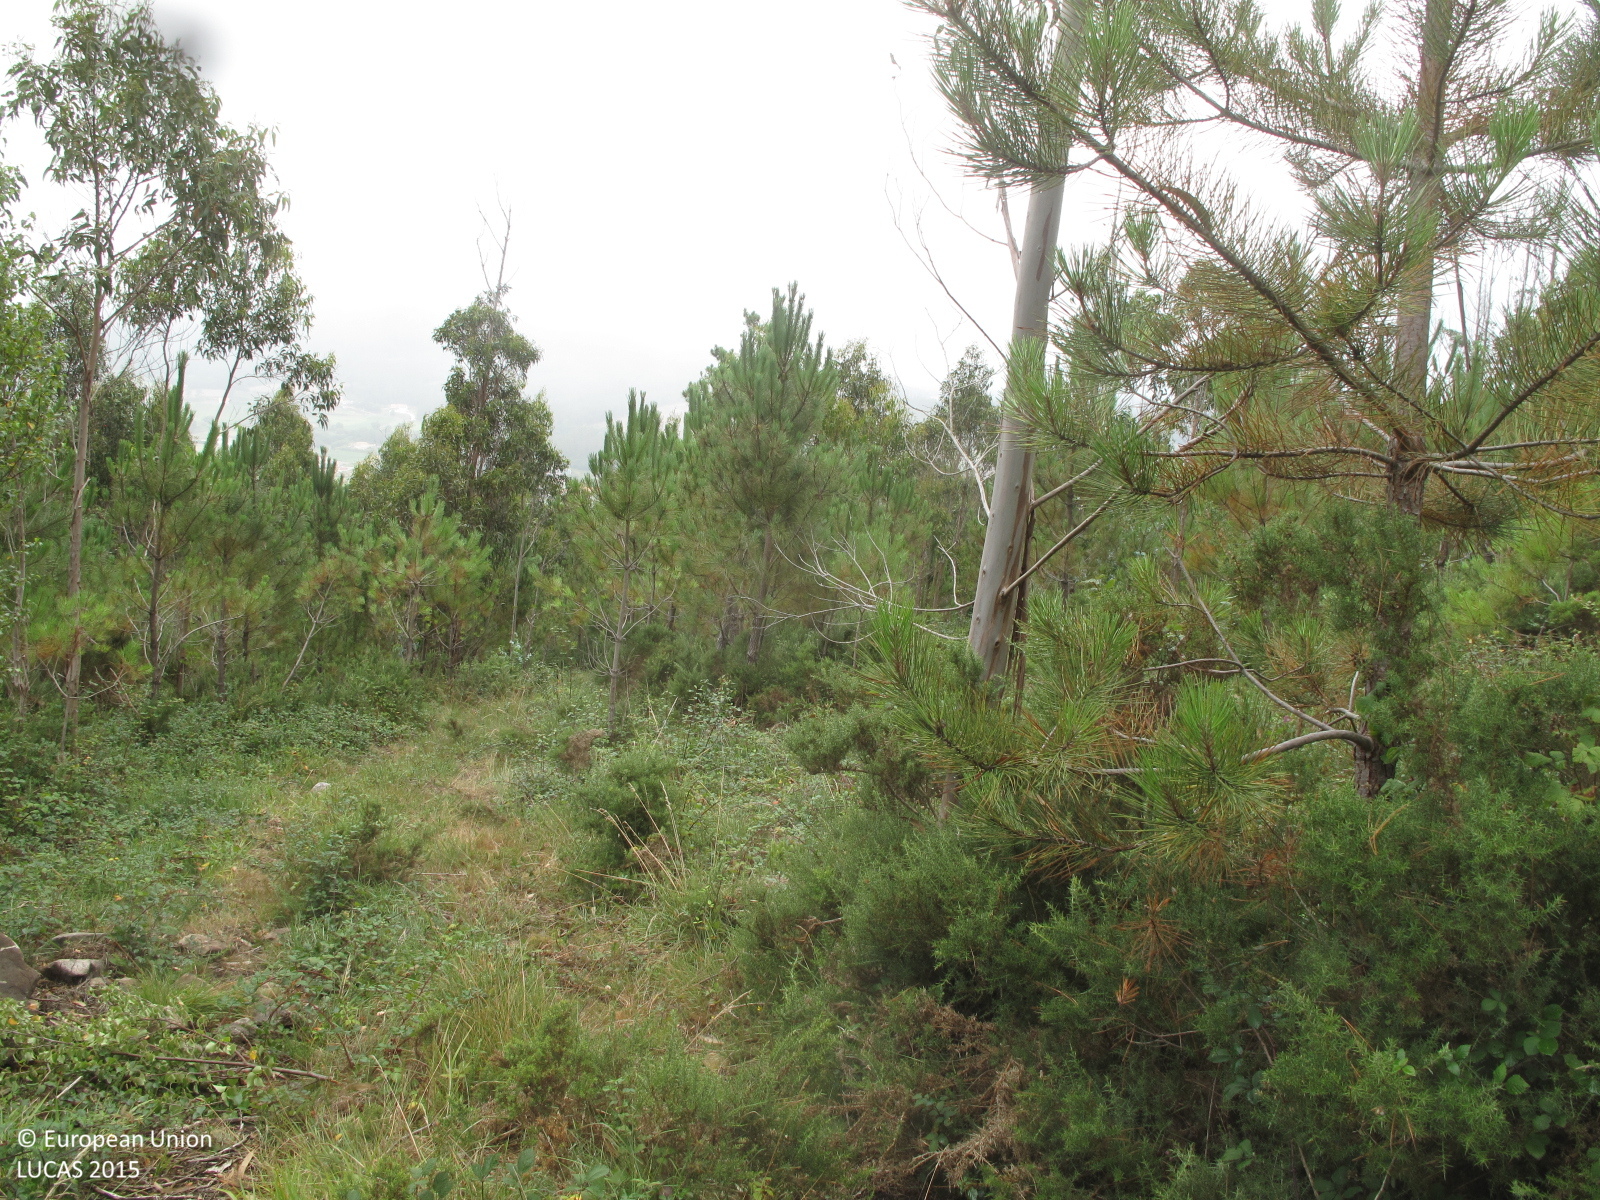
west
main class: Woodland
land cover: Other mixed woodland
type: exotic forest
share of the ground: 50 - 75 %
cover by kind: shrubs 40 %, broadleaved forest trees 30 %, coniferous forest trees 20 %, herbaceous plants 10 %
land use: Forestry
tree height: > 5 m
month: July
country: ES
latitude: 42.9859
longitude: -9.1726
